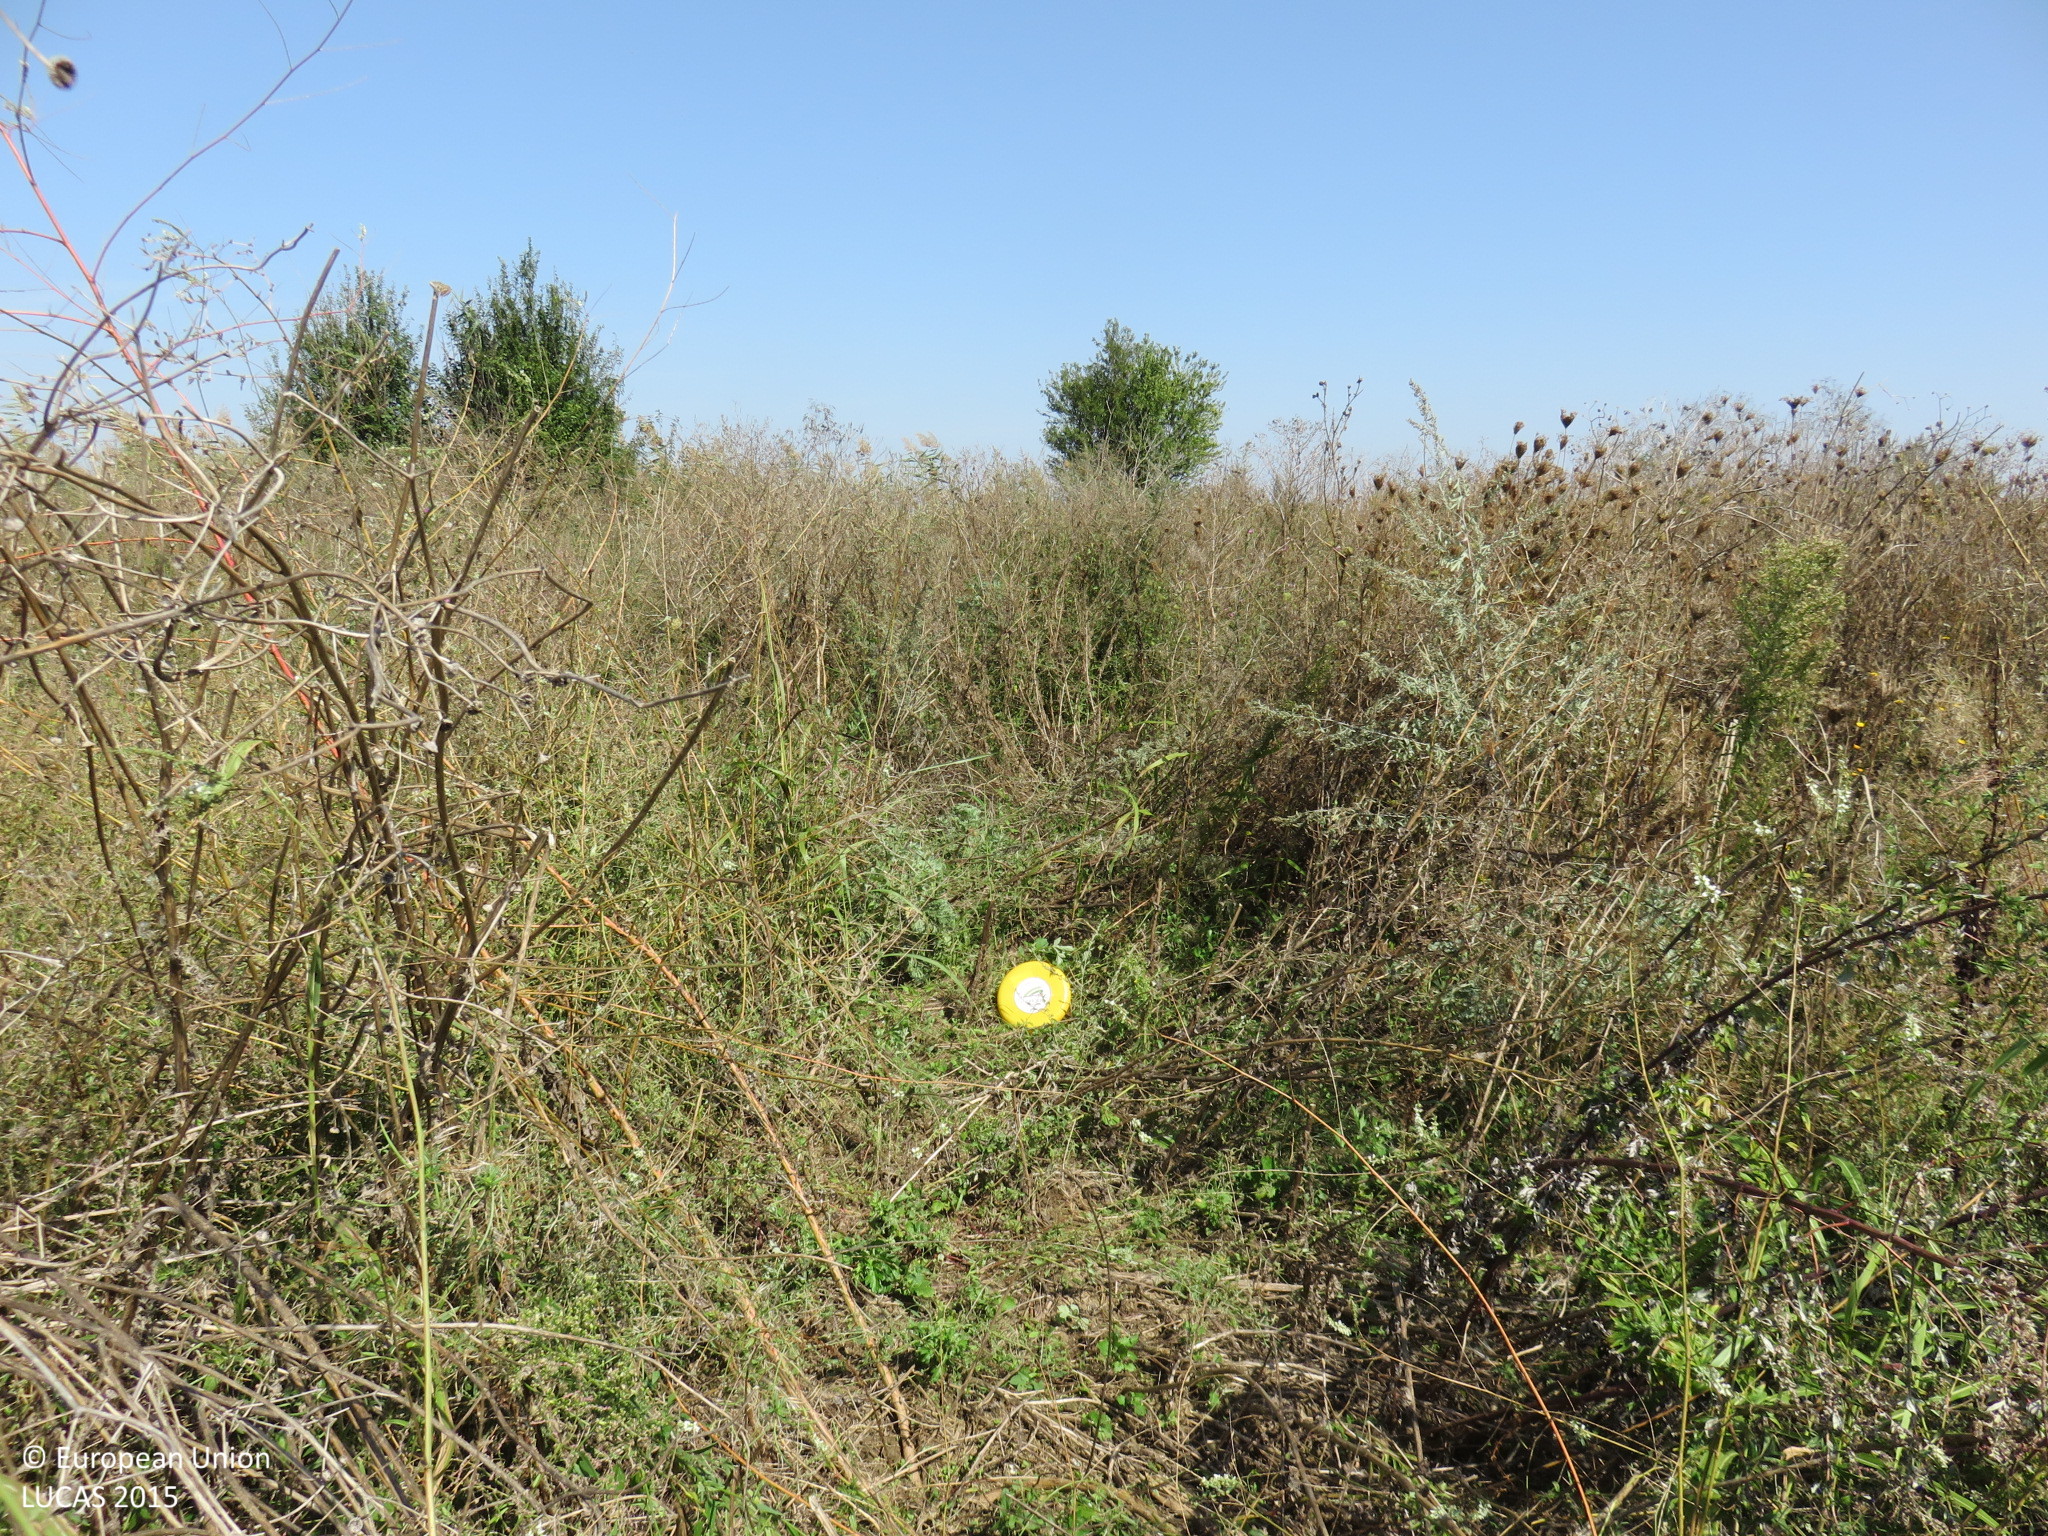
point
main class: Grassland
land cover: Spontaneously vegetated surfaces
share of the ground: > 75 %
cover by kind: herbaceous plants 100 %
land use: Agriculture (excluding fallow land and kitchen gardens)
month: September
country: BG
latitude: 43.7107
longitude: 24.6238
